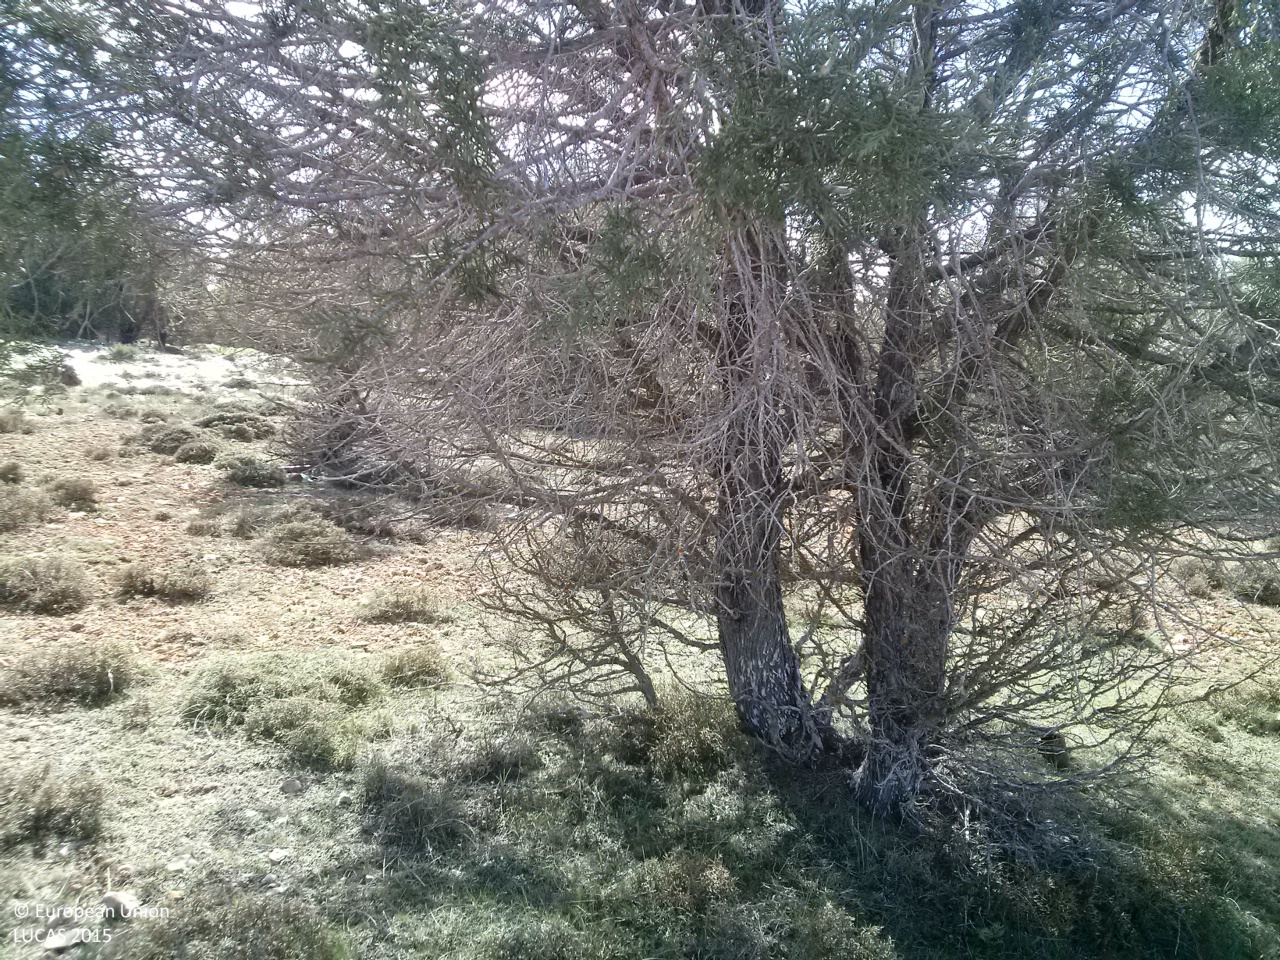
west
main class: Woodland
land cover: Other coniferous woodland
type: coniferous forest of the mediterranean region
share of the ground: 10 - 25 %
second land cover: Grassland without tree/shrub cover
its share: 25 - 50 %
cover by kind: unconsolidated bare surface 50 %, herbaceous plants 30 %, coniferous forest trees 15 %, shrubs 5 %
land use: Forestry
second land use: Agriculture (excluding fallow land and kitchen gardens)
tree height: < 5 m
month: April
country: ES
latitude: 40.0963
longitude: -1.6833
